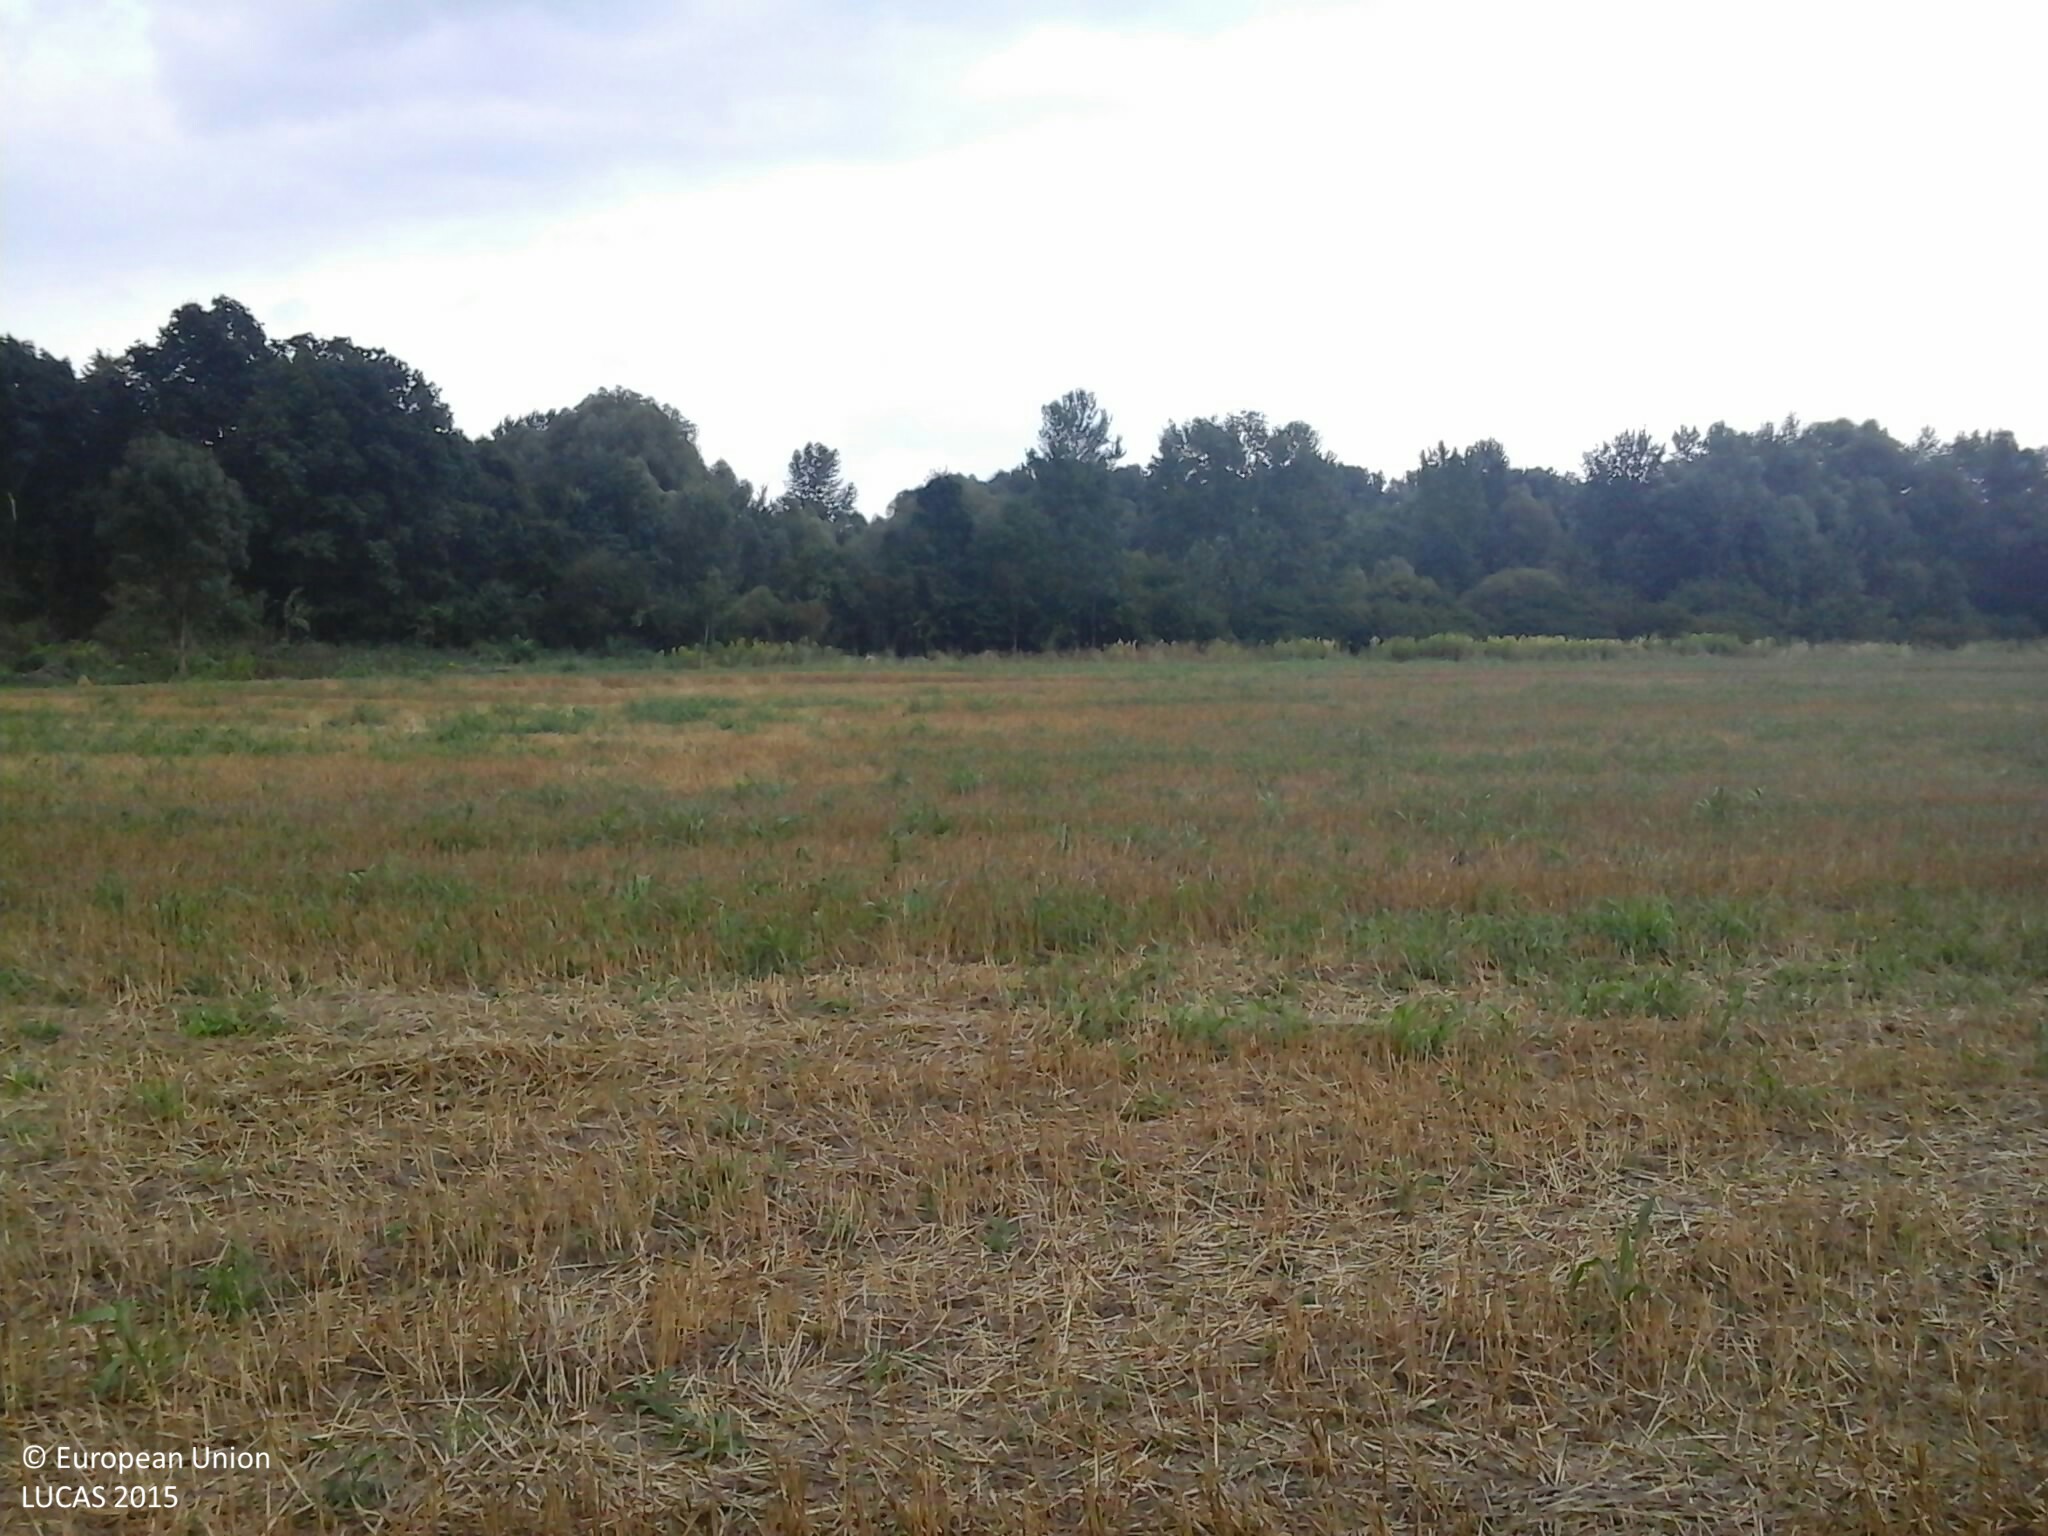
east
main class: Cropland
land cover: Common wheat
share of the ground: 25 - 50 %
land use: Agriculture (excluding fallow land and kitchen gardens)
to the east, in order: Common wheat; Spontaneously vegetated surfaces; Broadleaved woodland
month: August
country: HU
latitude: 45.8064
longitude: 18.1250
